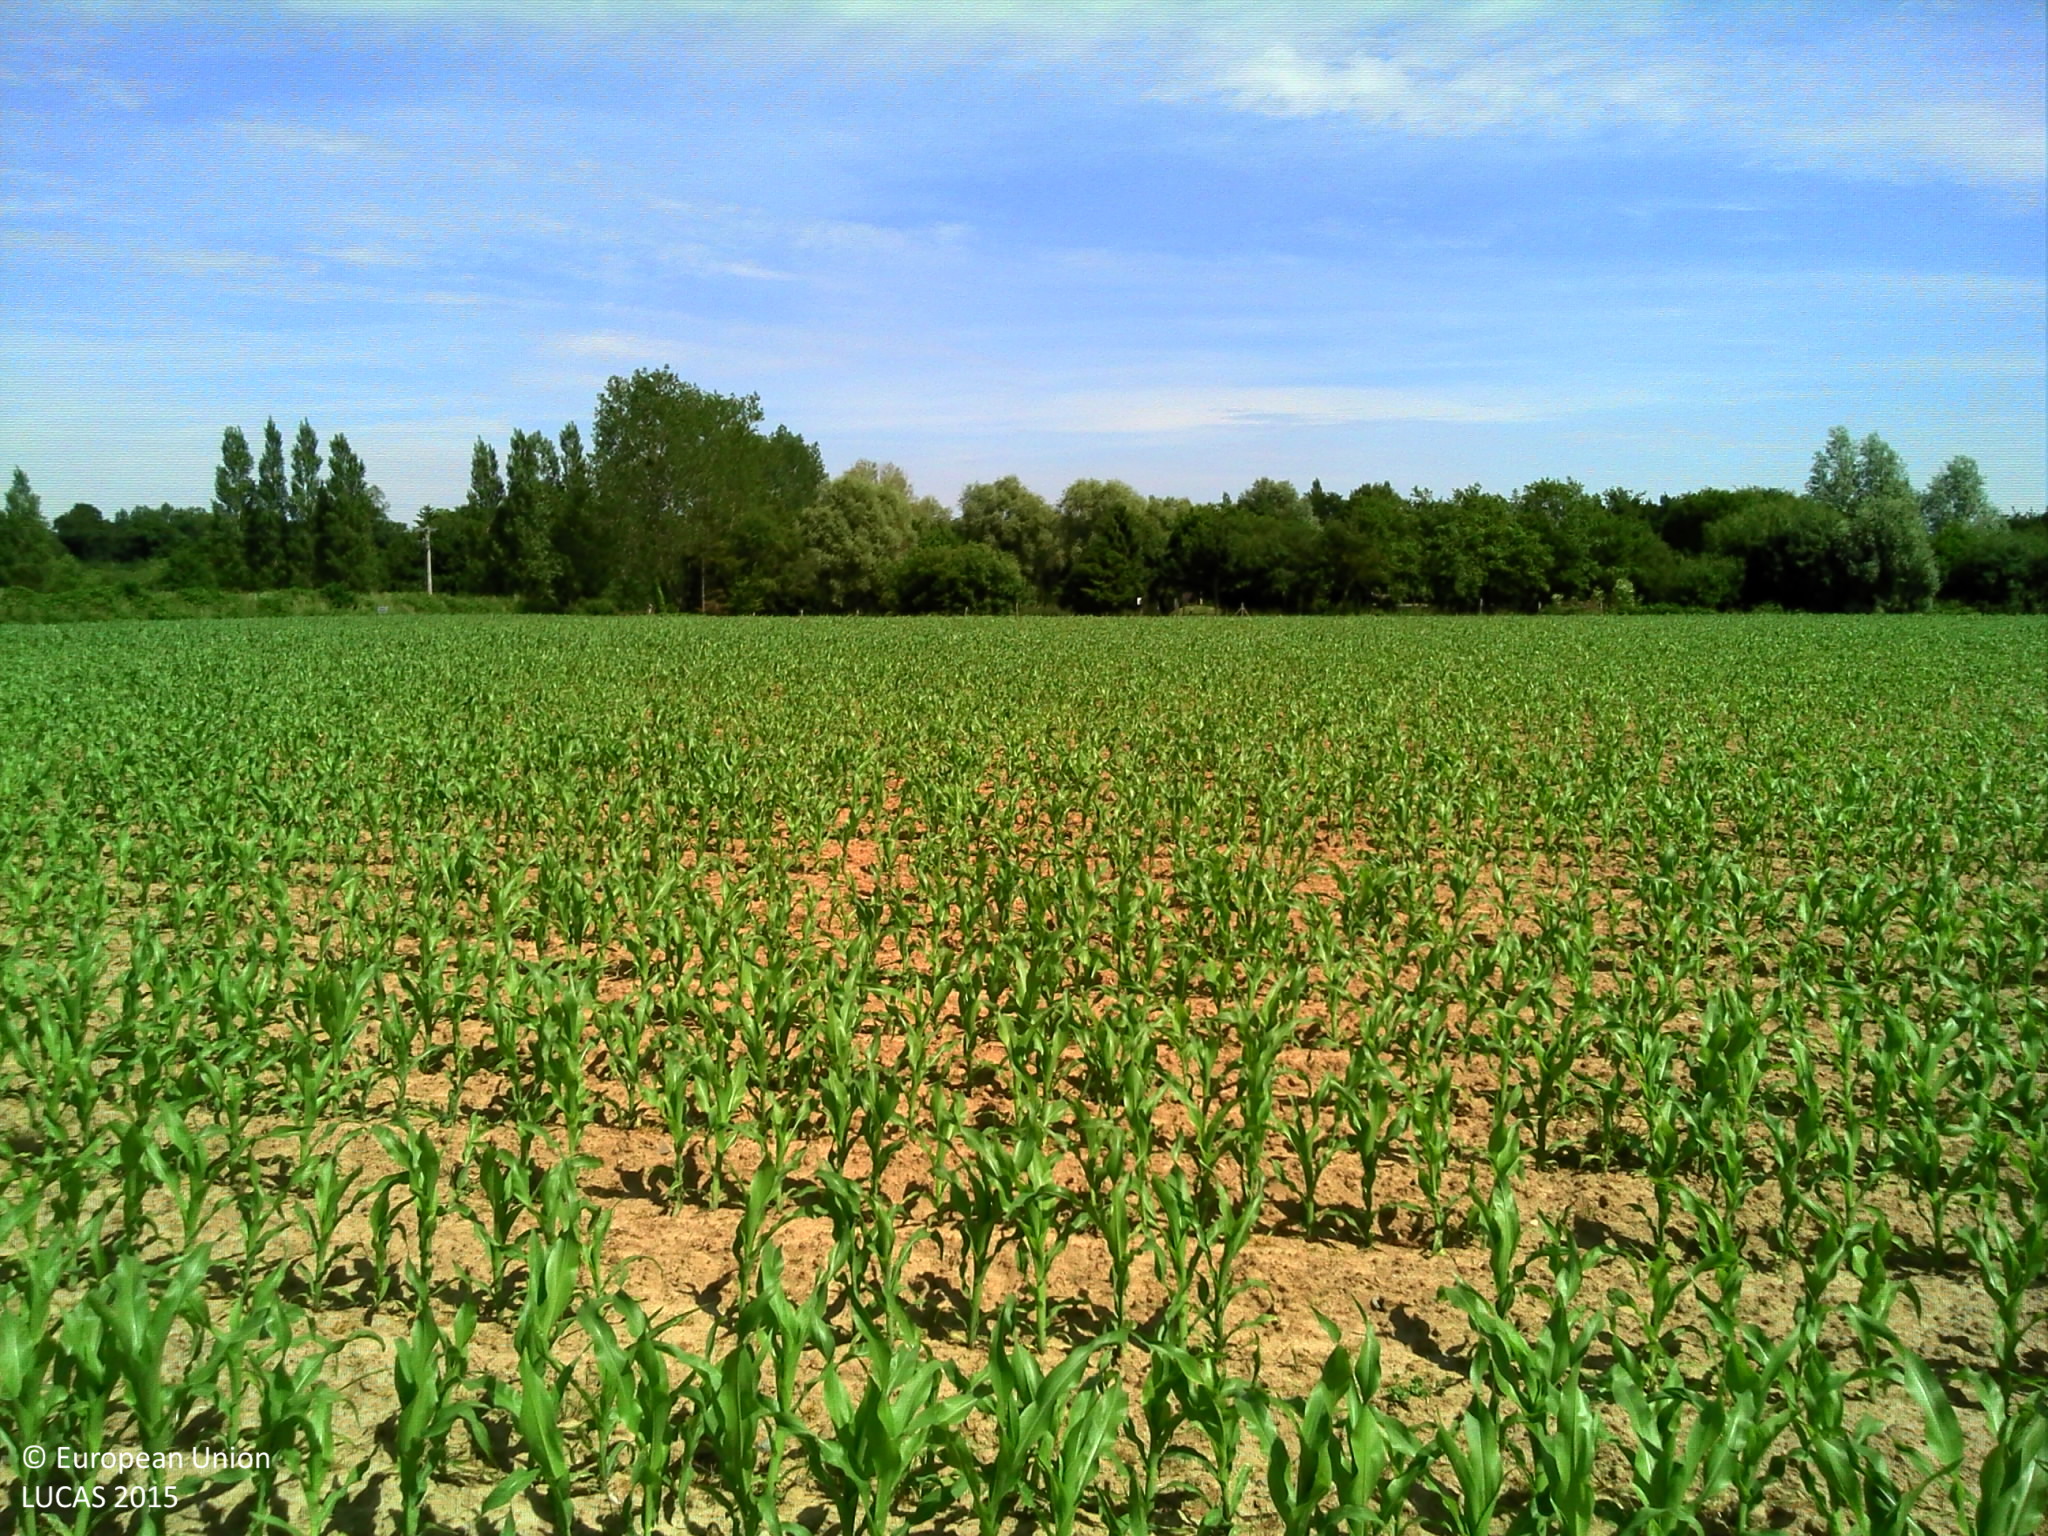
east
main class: Cropland
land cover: Maize
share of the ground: 25 - 50 %
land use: Agriculture (excluding fallow land and kitchen gardens)
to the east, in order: Maize; Grass margins; Paved roads, cycling and walking lanes; Grass margins; Abandoned hedges; Maize; Lines of trees; Grassland with sparse tree/shrub cover; Broadleaved woodland; Artificial constructions in urban areas
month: June
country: FR
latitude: 49.1808
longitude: -1.3371
